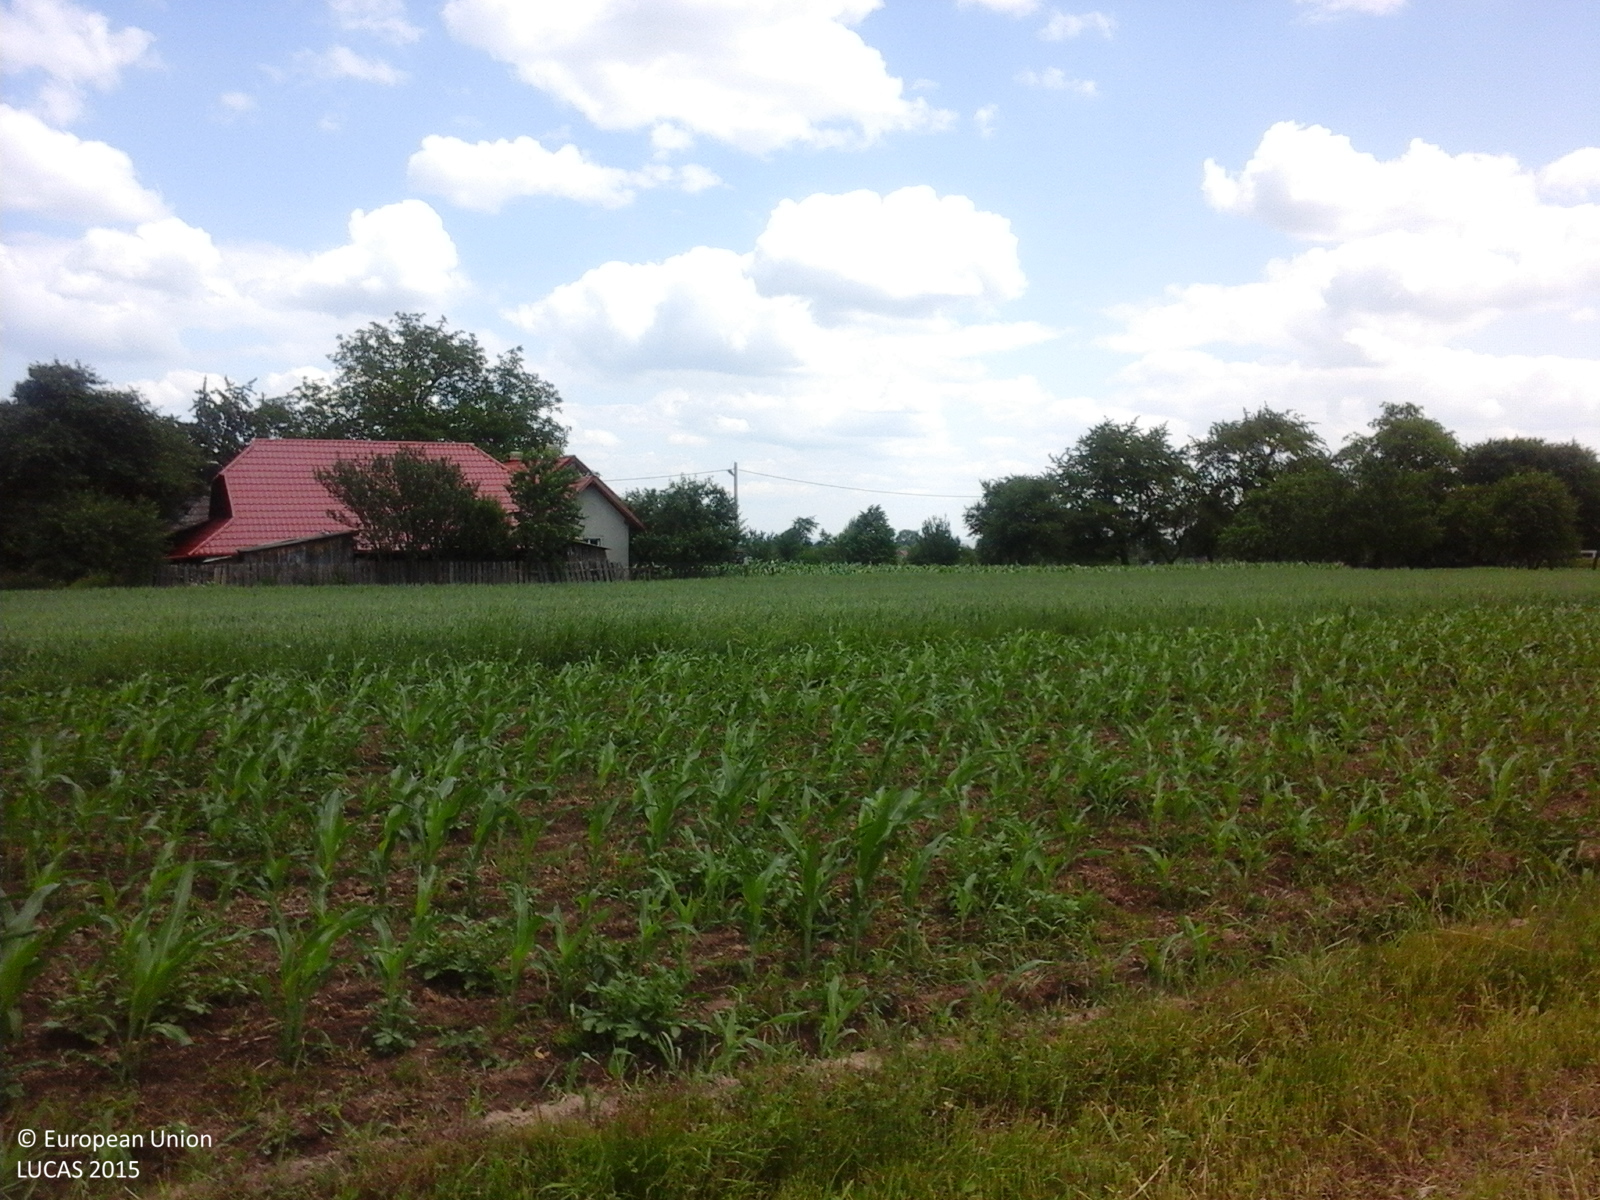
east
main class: Grassland
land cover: Grassland without tree/shrub cover
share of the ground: > 75 %
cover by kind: herbaceous plants 100 %
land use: Agriculture (excluding fallow land and kitchen gardens)
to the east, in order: Grassland without tree/shrub cover; Maize; Oats; Maize; Potatoes; Fences; Electric lines; Grass margins; Tracks; Grass margins; Lucerne; Grass margins; Maize; Abandoned hedges; Fences; Grass margins; Other fresh vegetables; Grassland without tree/shrub cover; Abandoned hedges; Fences; Grassland without tree/shrub cover; Maize; Lines of trees; Grassland without tree/shrub cover
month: June
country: RO
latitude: 47.8408
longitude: 25.8265
